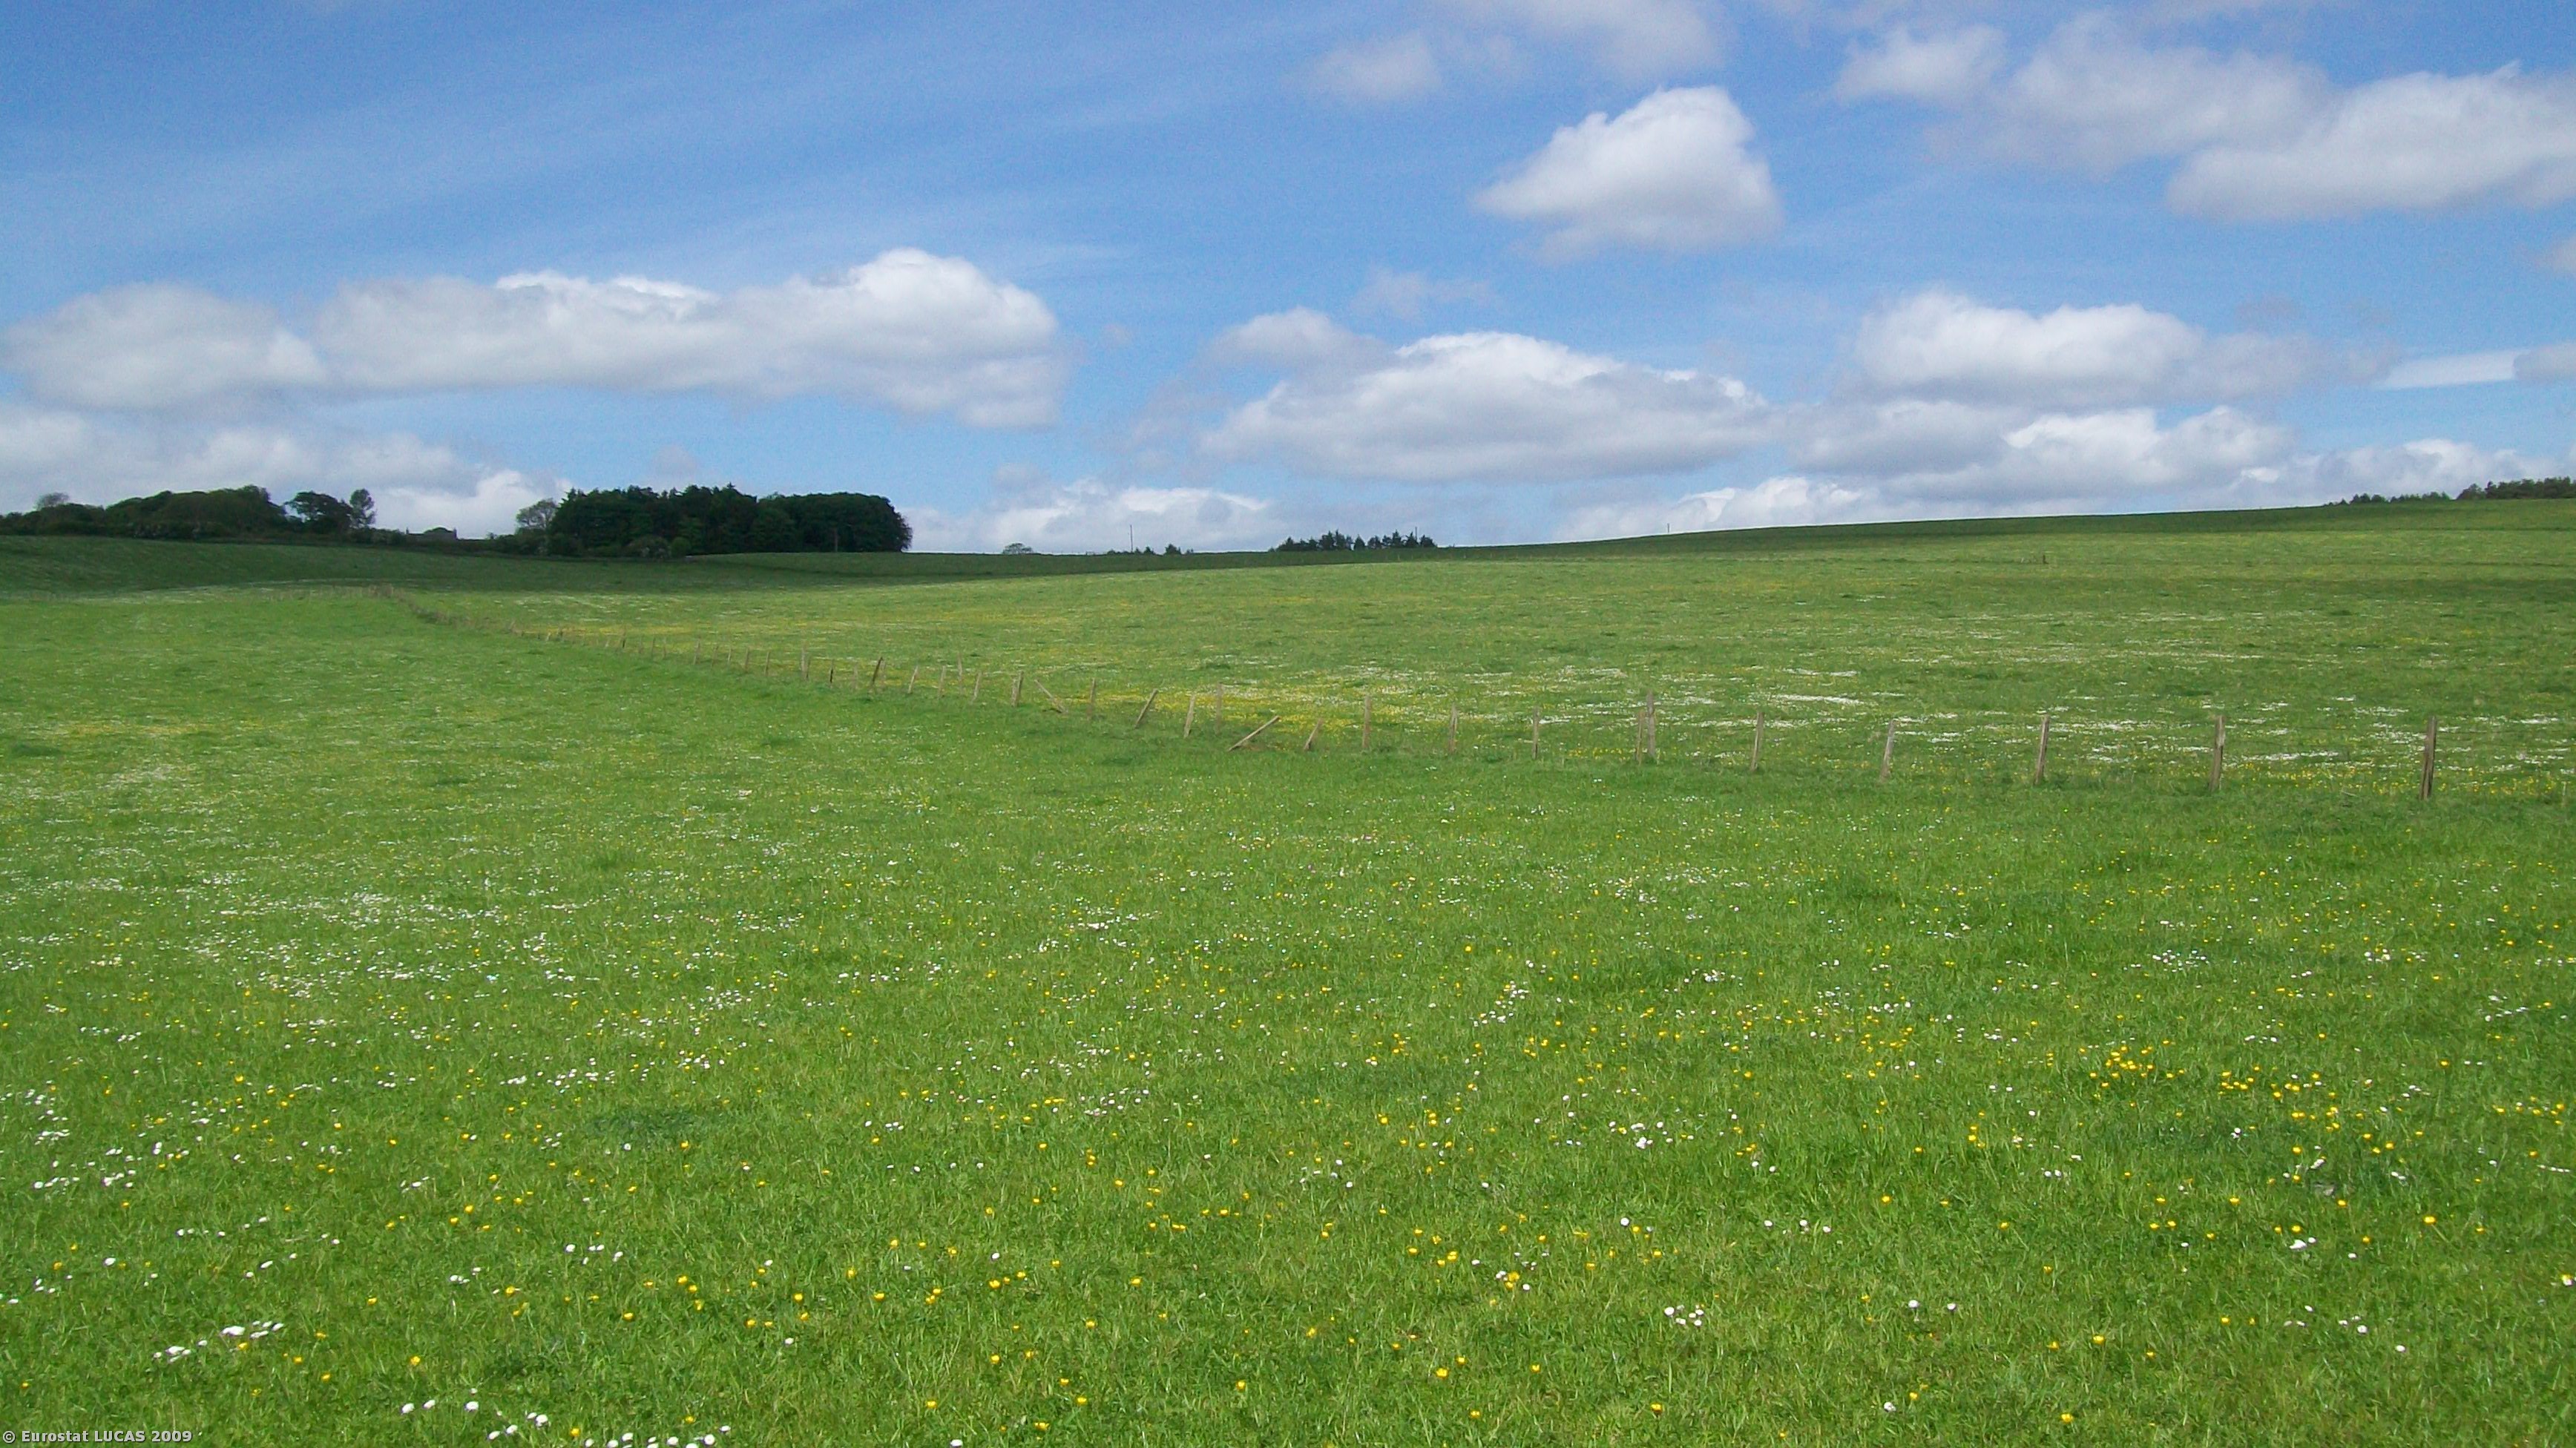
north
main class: Grassland
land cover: Grassland without tree/shrub cover
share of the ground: > 75 %
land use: Agriculture (excluding fallow land and kitchen gardens)
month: June
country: GB
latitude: 55.7045
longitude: -3.5256
